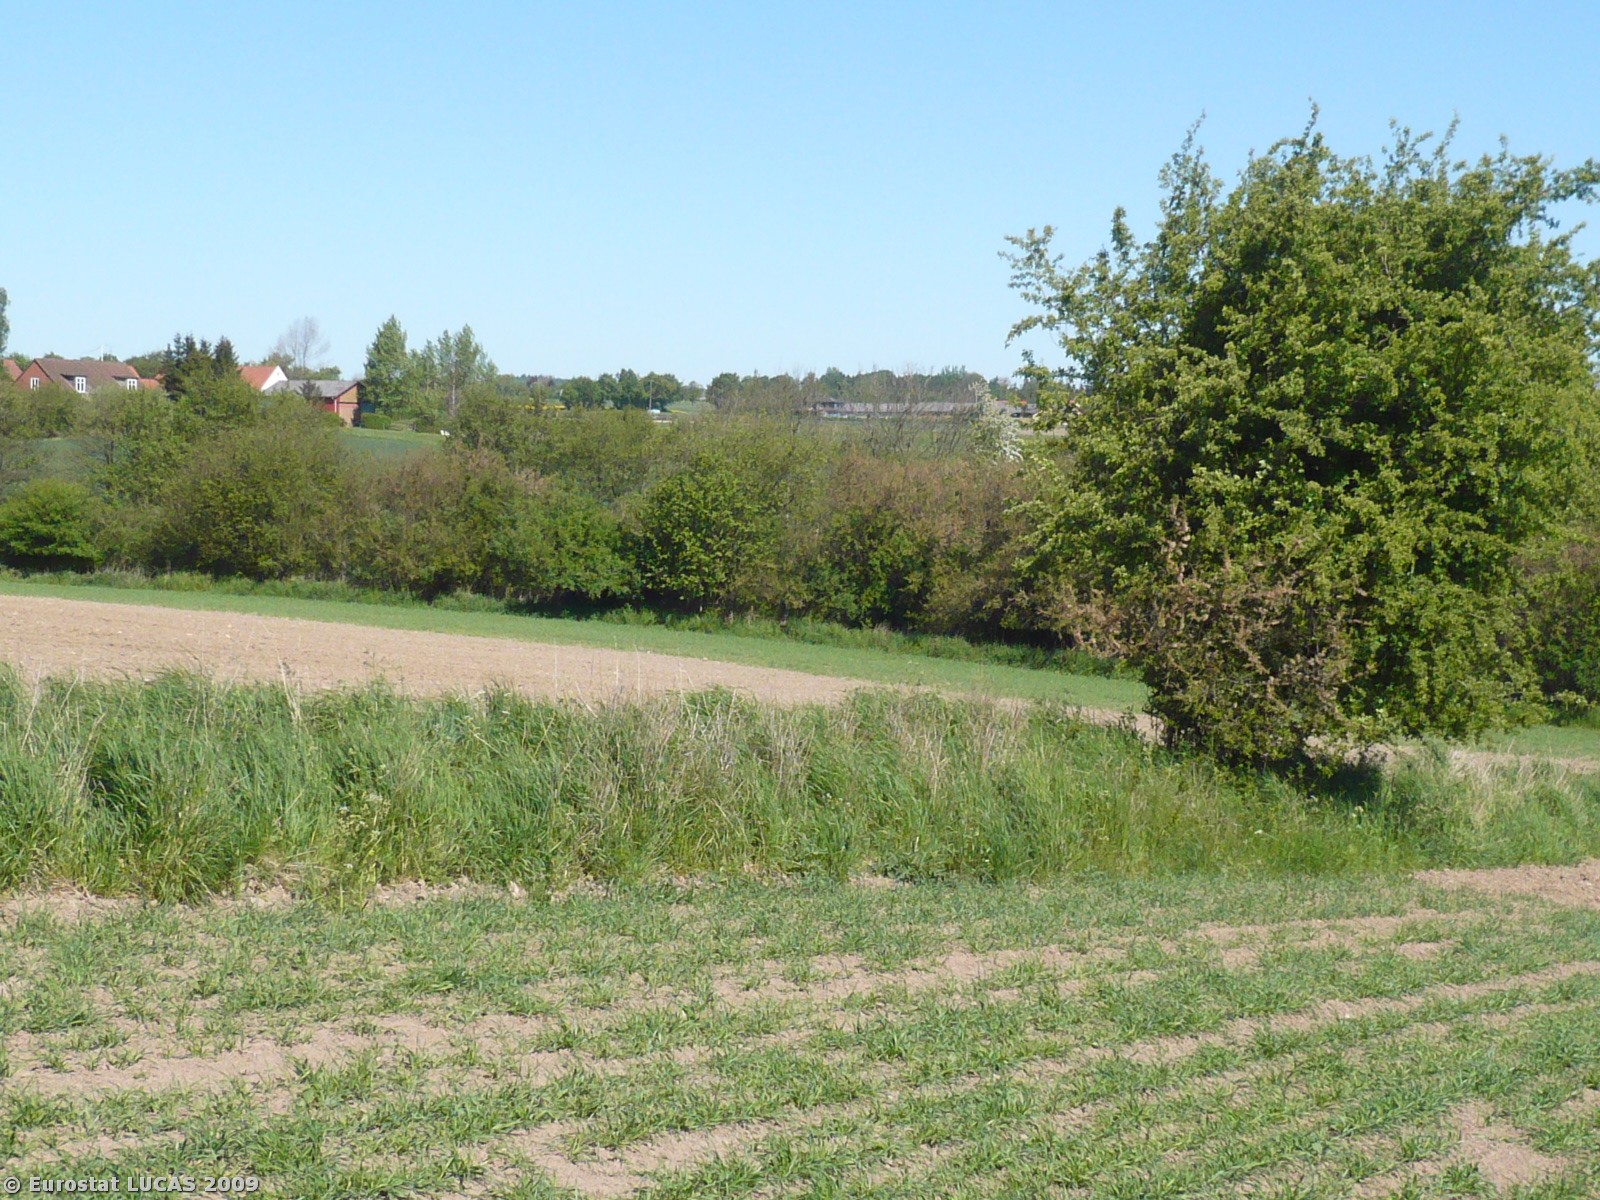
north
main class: Grassland
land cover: Grassland without tree/shrub cover
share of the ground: > 75 %
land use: Agriculture (excluding fallow land and kitchen gardens)
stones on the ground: < 10 %
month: May
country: DK
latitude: 55.1654
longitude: 11.9922
